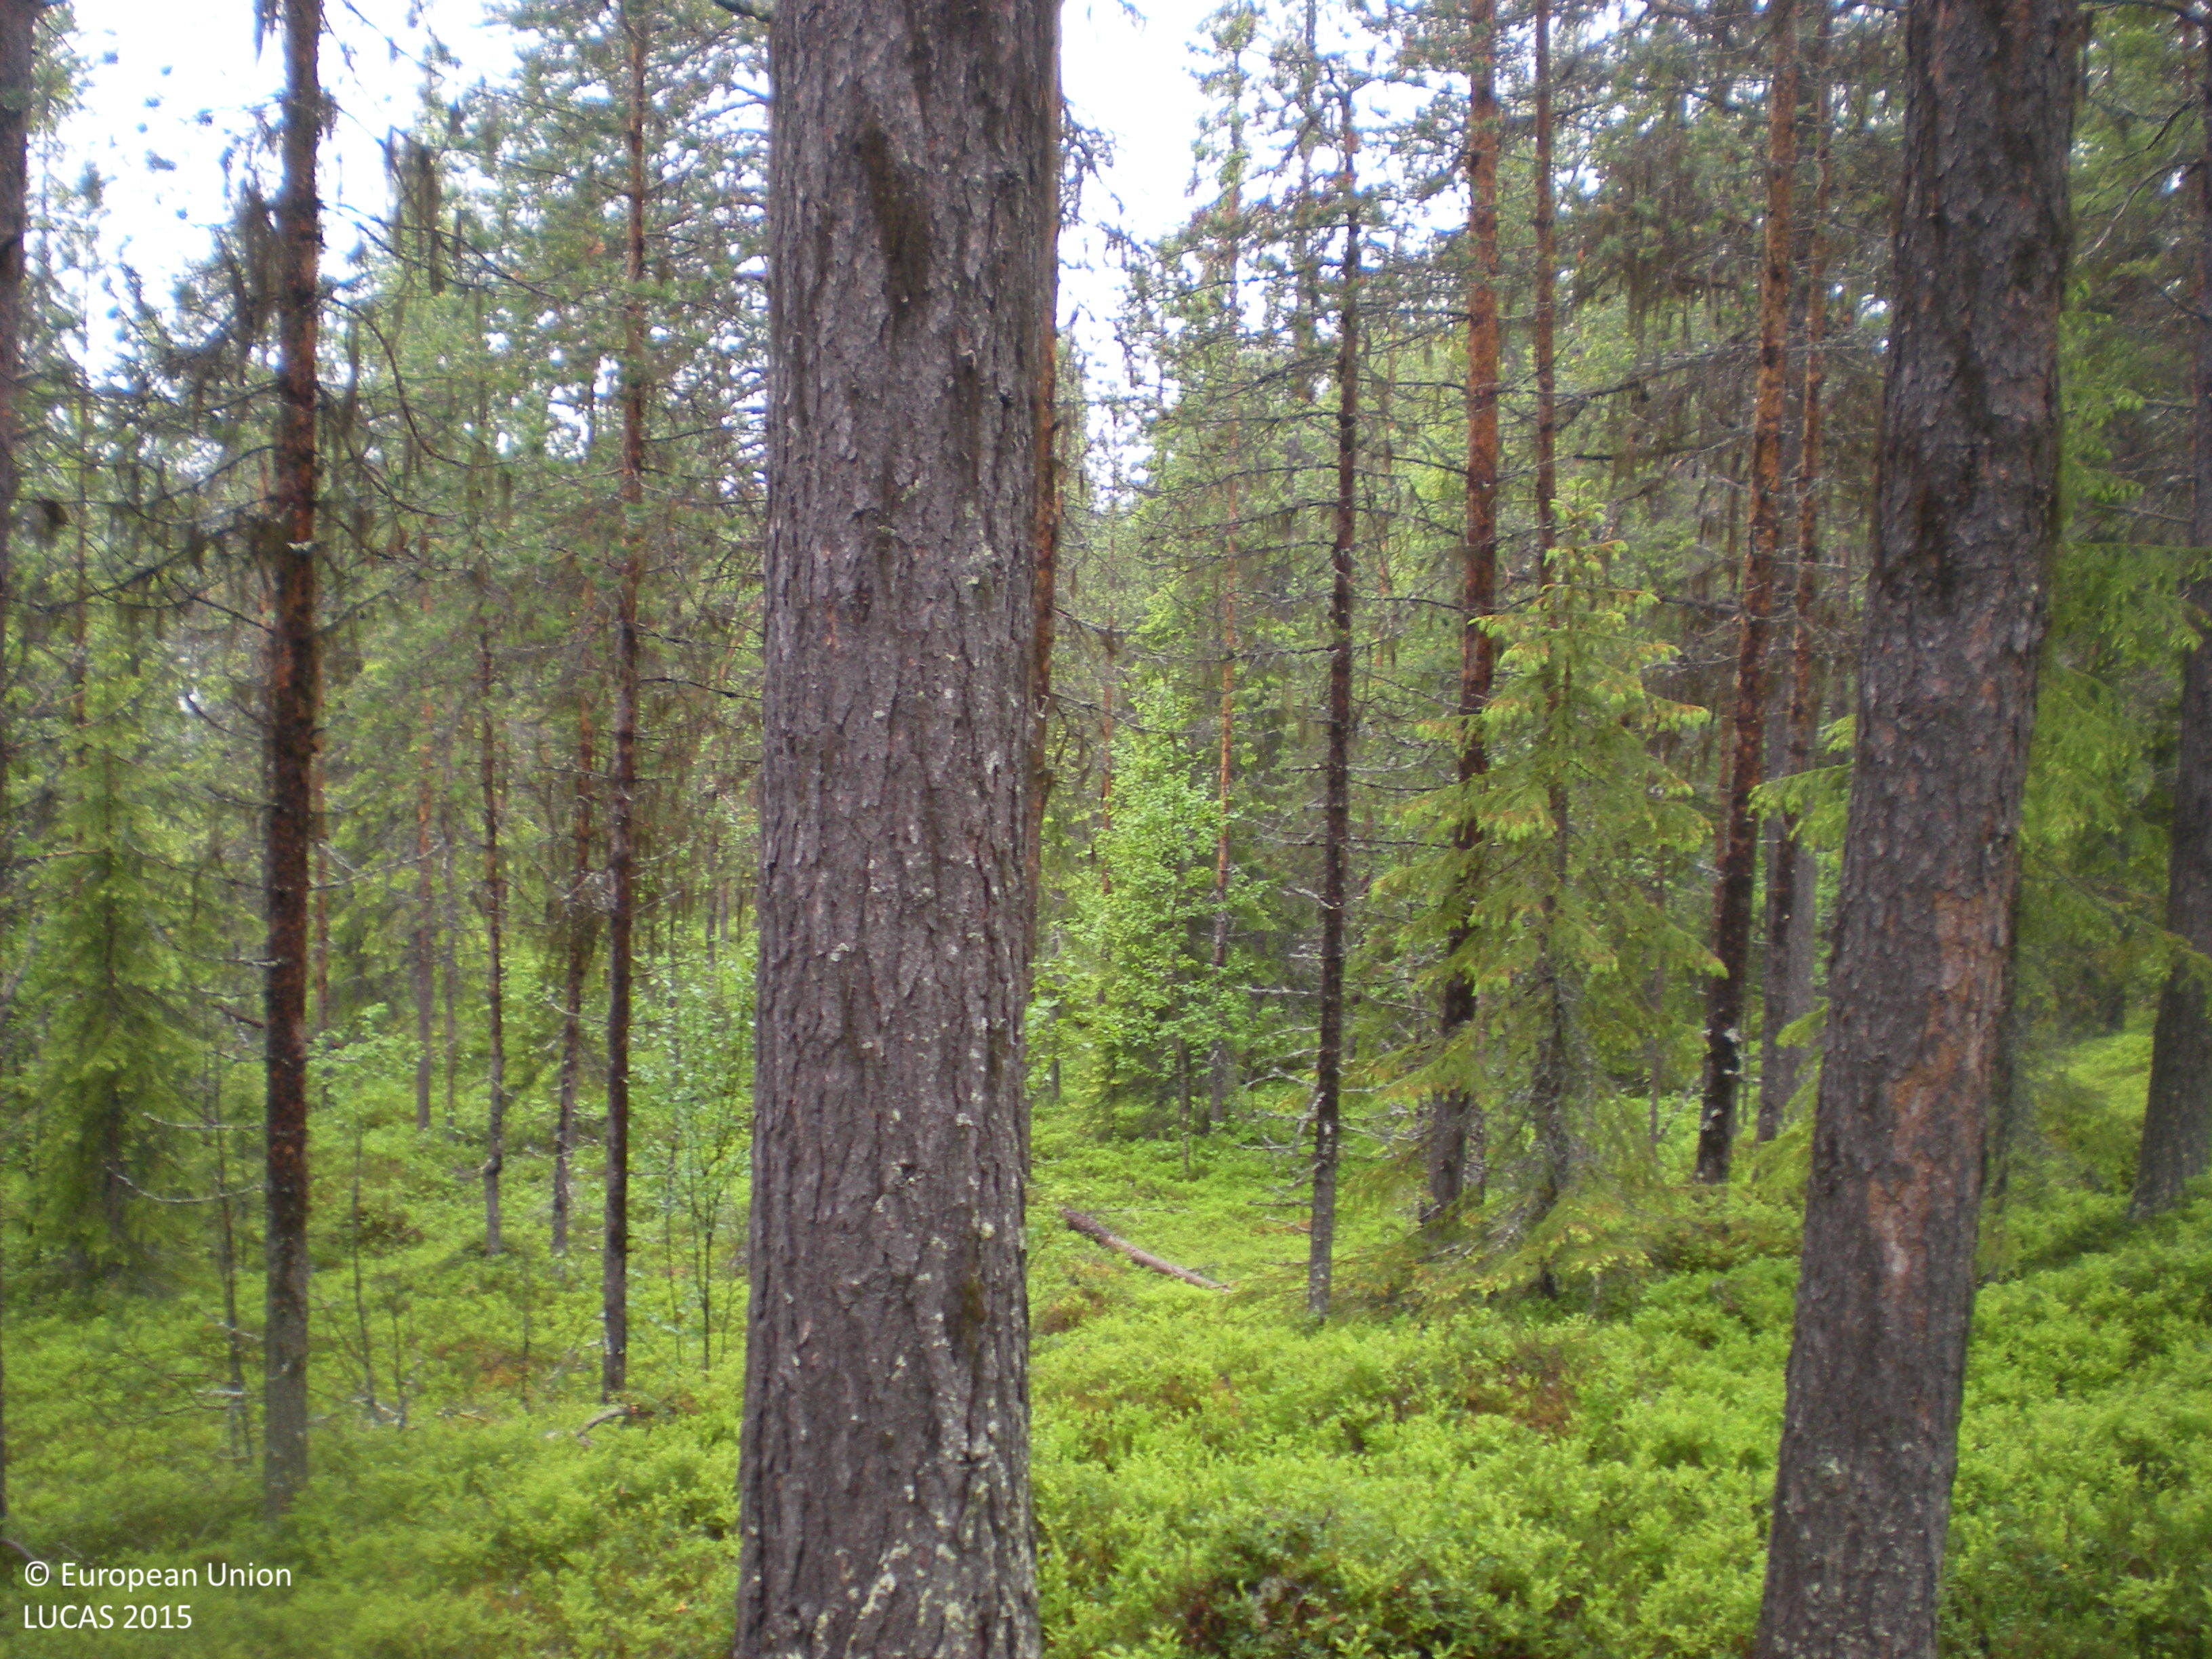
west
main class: Woodland
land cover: Pine dominated coniferous woodland
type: boreal forest
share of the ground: 50 - 75 %
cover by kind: coniferous forest trees 60 %, shrubs 20 %, broadleaved forest trees 10 %, lichens and mosses 10 %
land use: Forestry
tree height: > 5 m
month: July
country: SE
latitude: 66.0241
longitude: 17.3881
